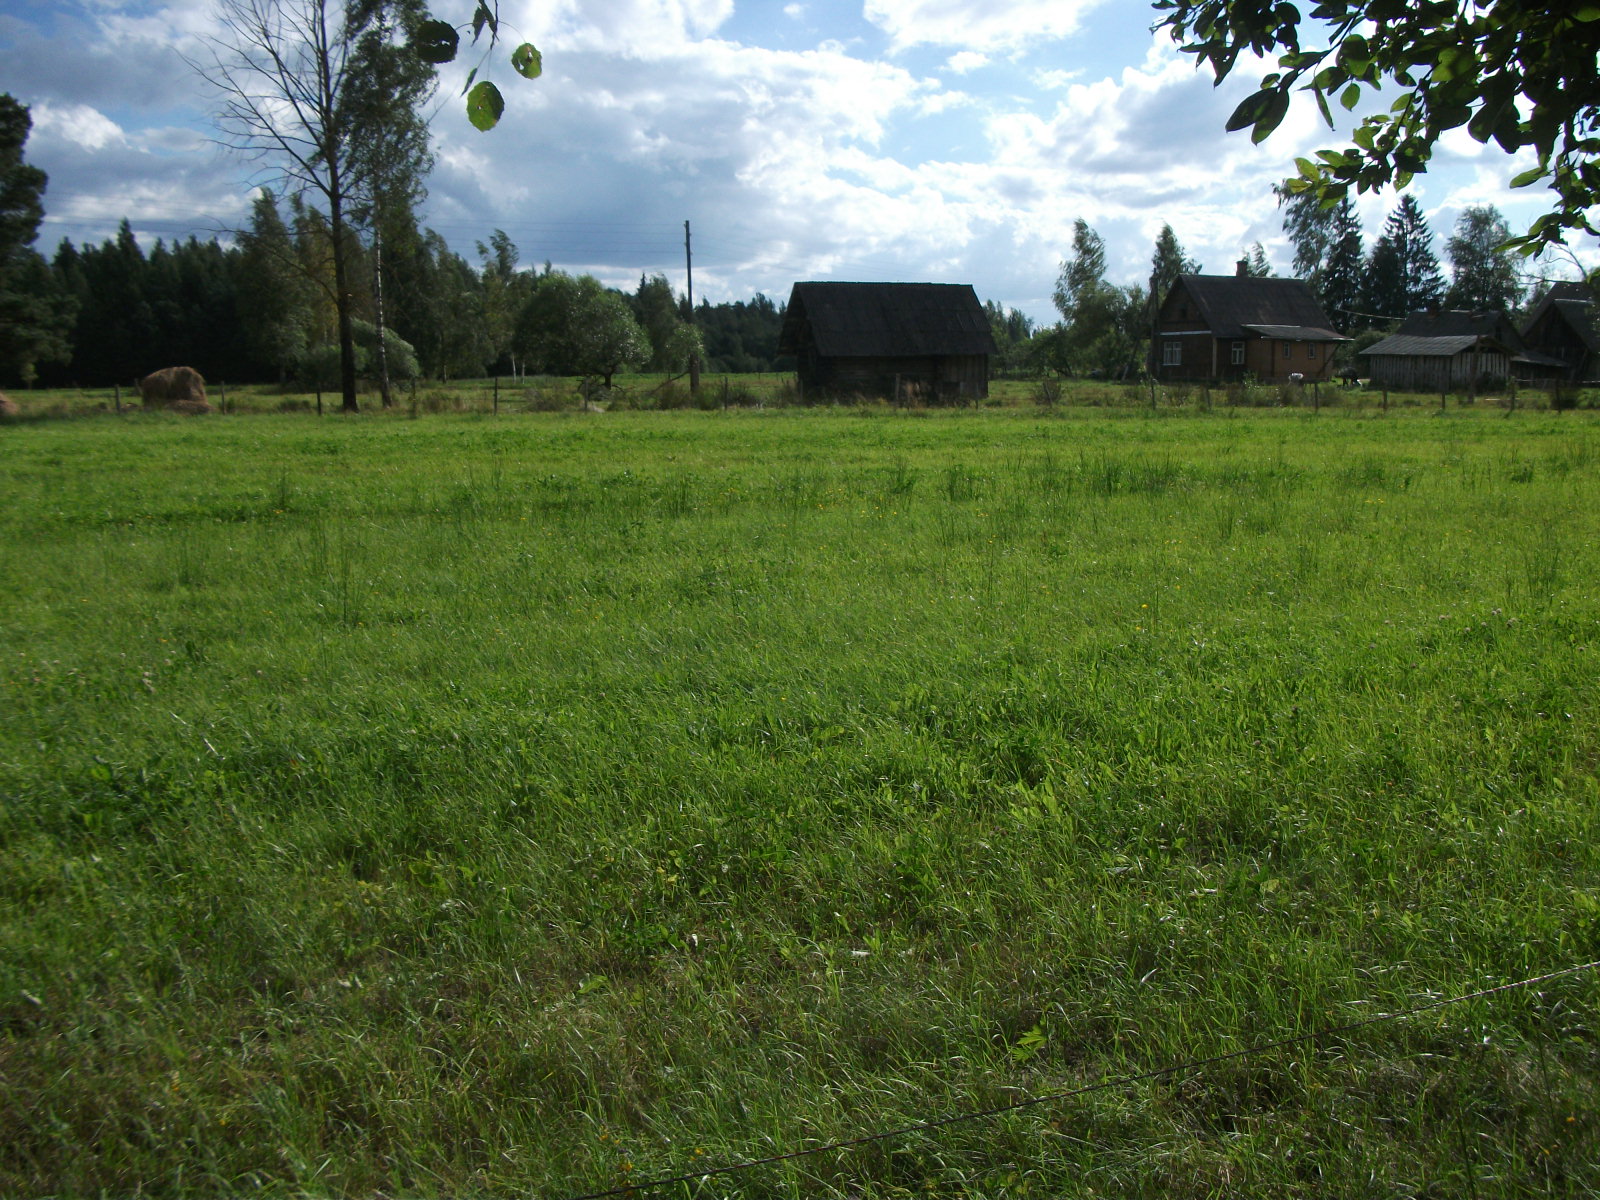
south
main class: Grassland
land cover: Grassland without tree/shrub cover
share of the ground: > 75 %
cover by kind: herbaceous plants 100 %
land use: Agriculture (excluding fallow land and kitchen gardens)
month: August
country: LV
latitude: 56.4873
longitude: 26.3677
